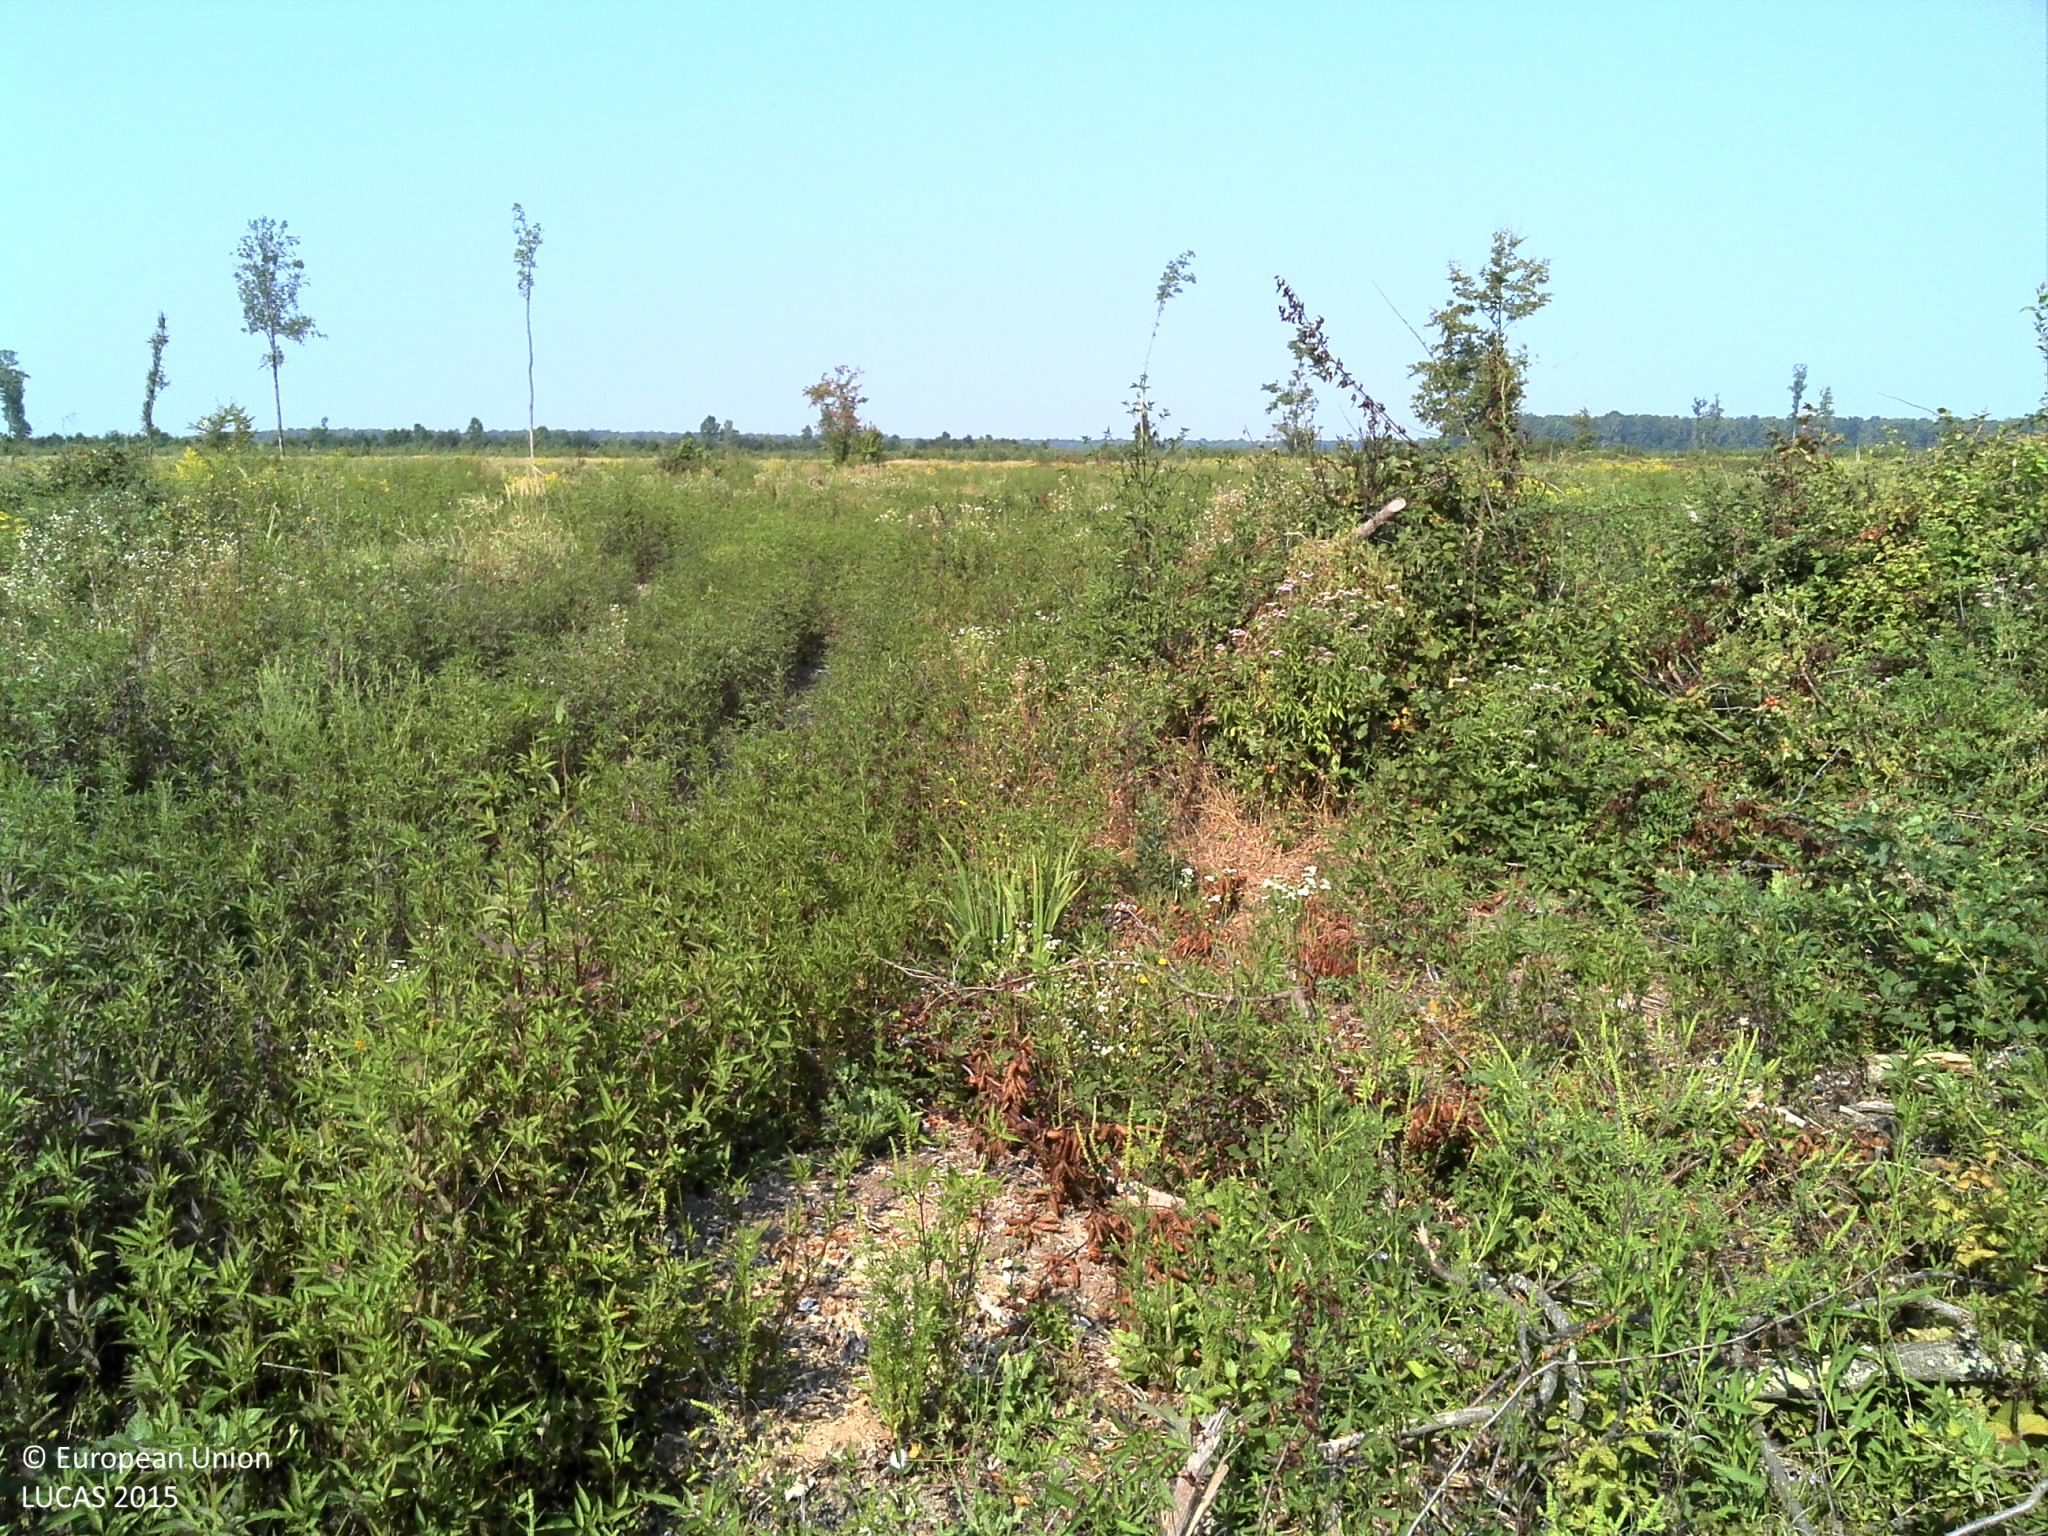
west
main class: Grassland
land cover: Spontaneously vegetated surfaces
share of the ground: > 75 %
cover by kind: herbaceous plants 100 %
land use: Semi-natural and natural areas not in use
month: August
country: HR
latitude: 45.0990
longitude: 18.8129
